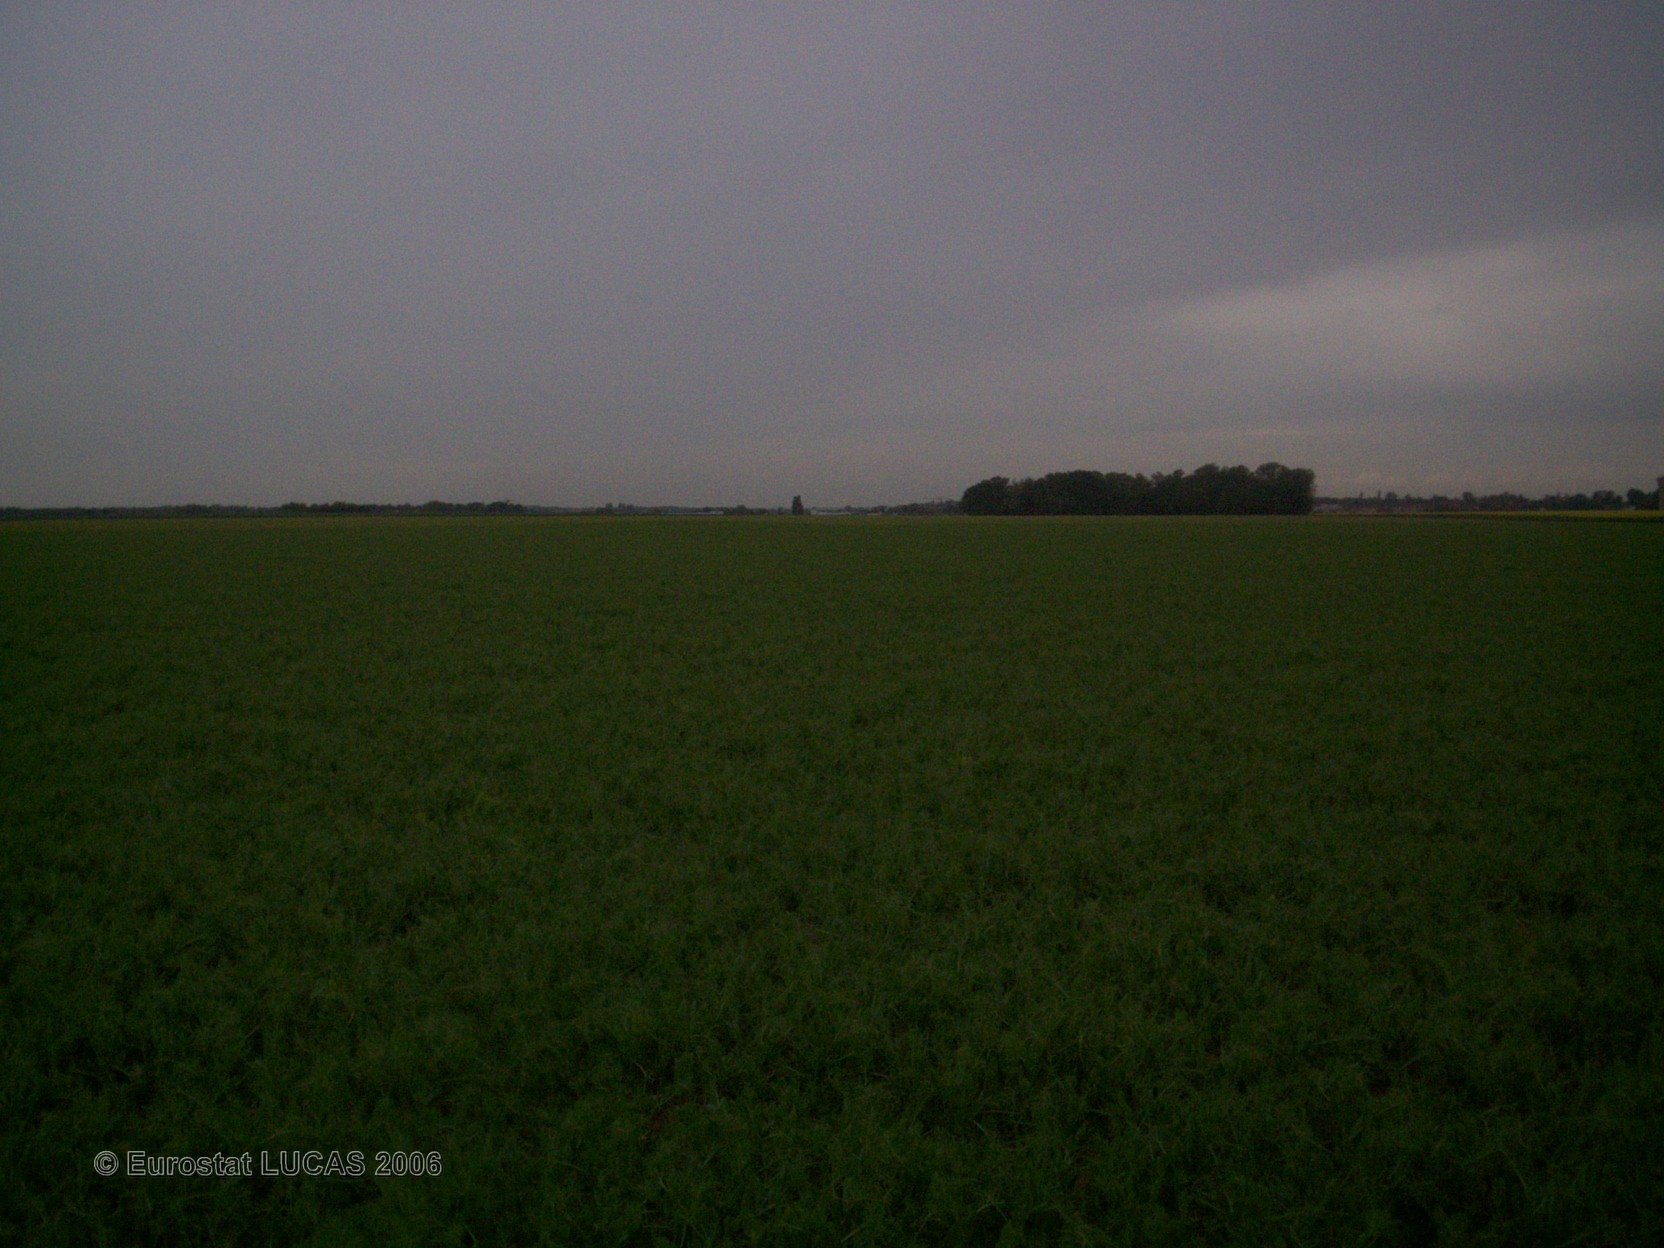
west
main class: Cropland
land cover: Dry pulses
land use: Agriculture (excluding fallow land and kitchen gardens)
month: May
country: FR
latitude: 48.6695
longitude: 2.7254
